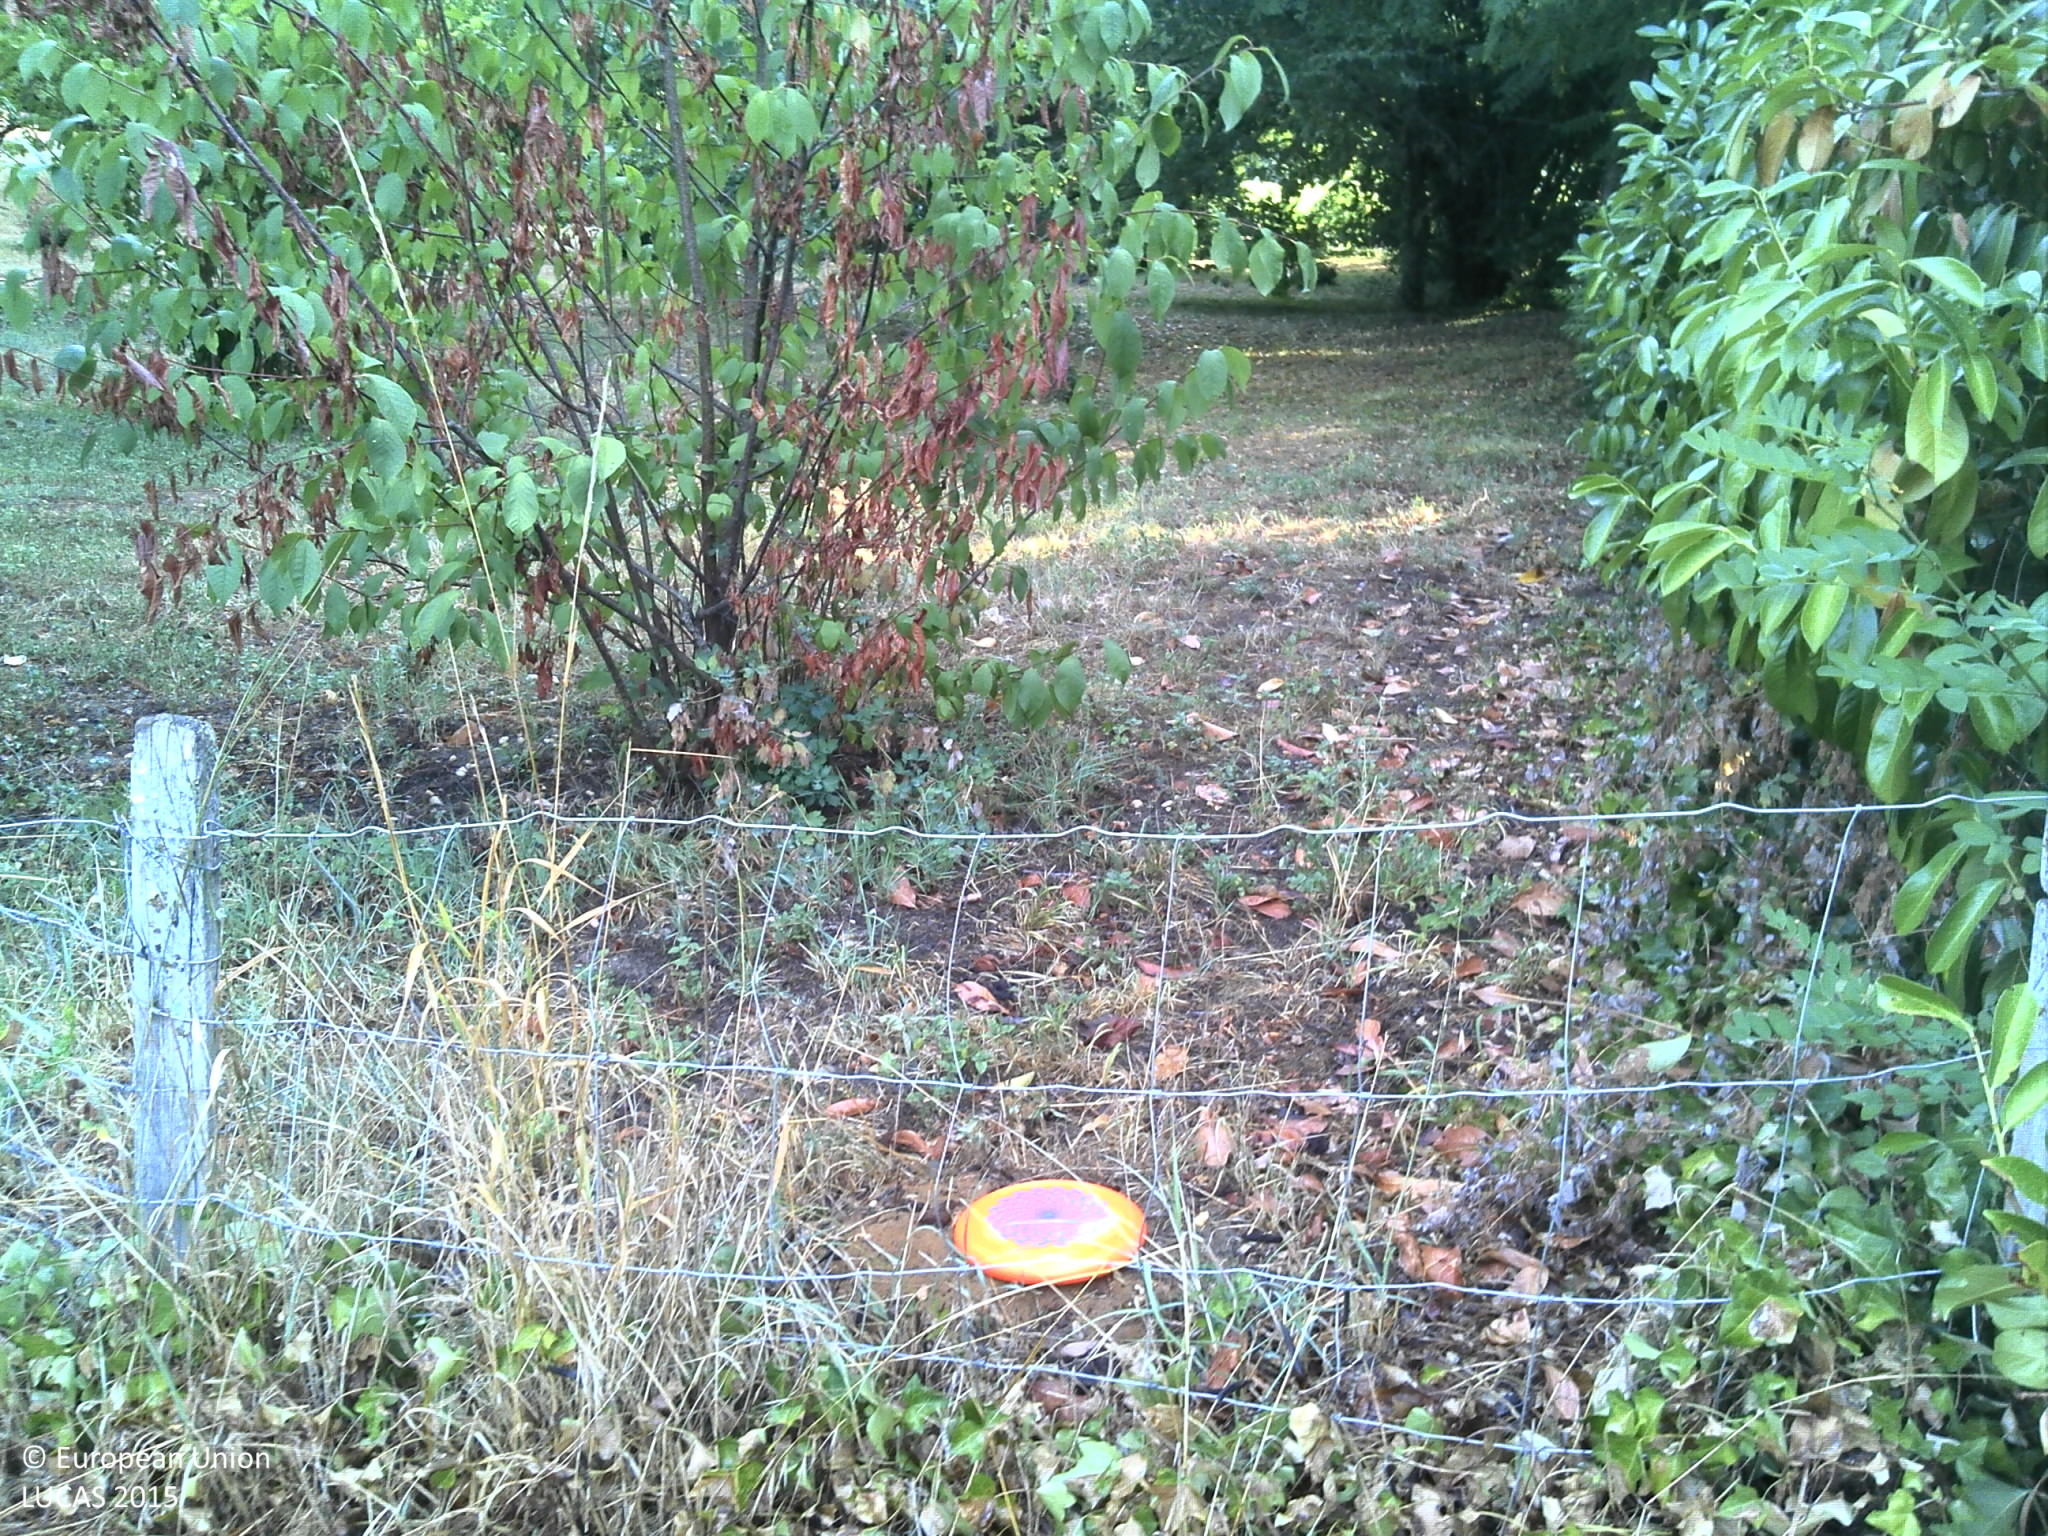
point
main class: Woodland
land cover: Other mixed woodland
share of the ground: > 75 %
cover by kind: coniferous forest trees 30 %, broadleaved forest trees 30 %, shrubs 30 %, herbaceous plants 10 %
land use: Residential
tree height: < 5 m
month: July
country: FR
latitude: 44.7343
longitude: -0.5874
